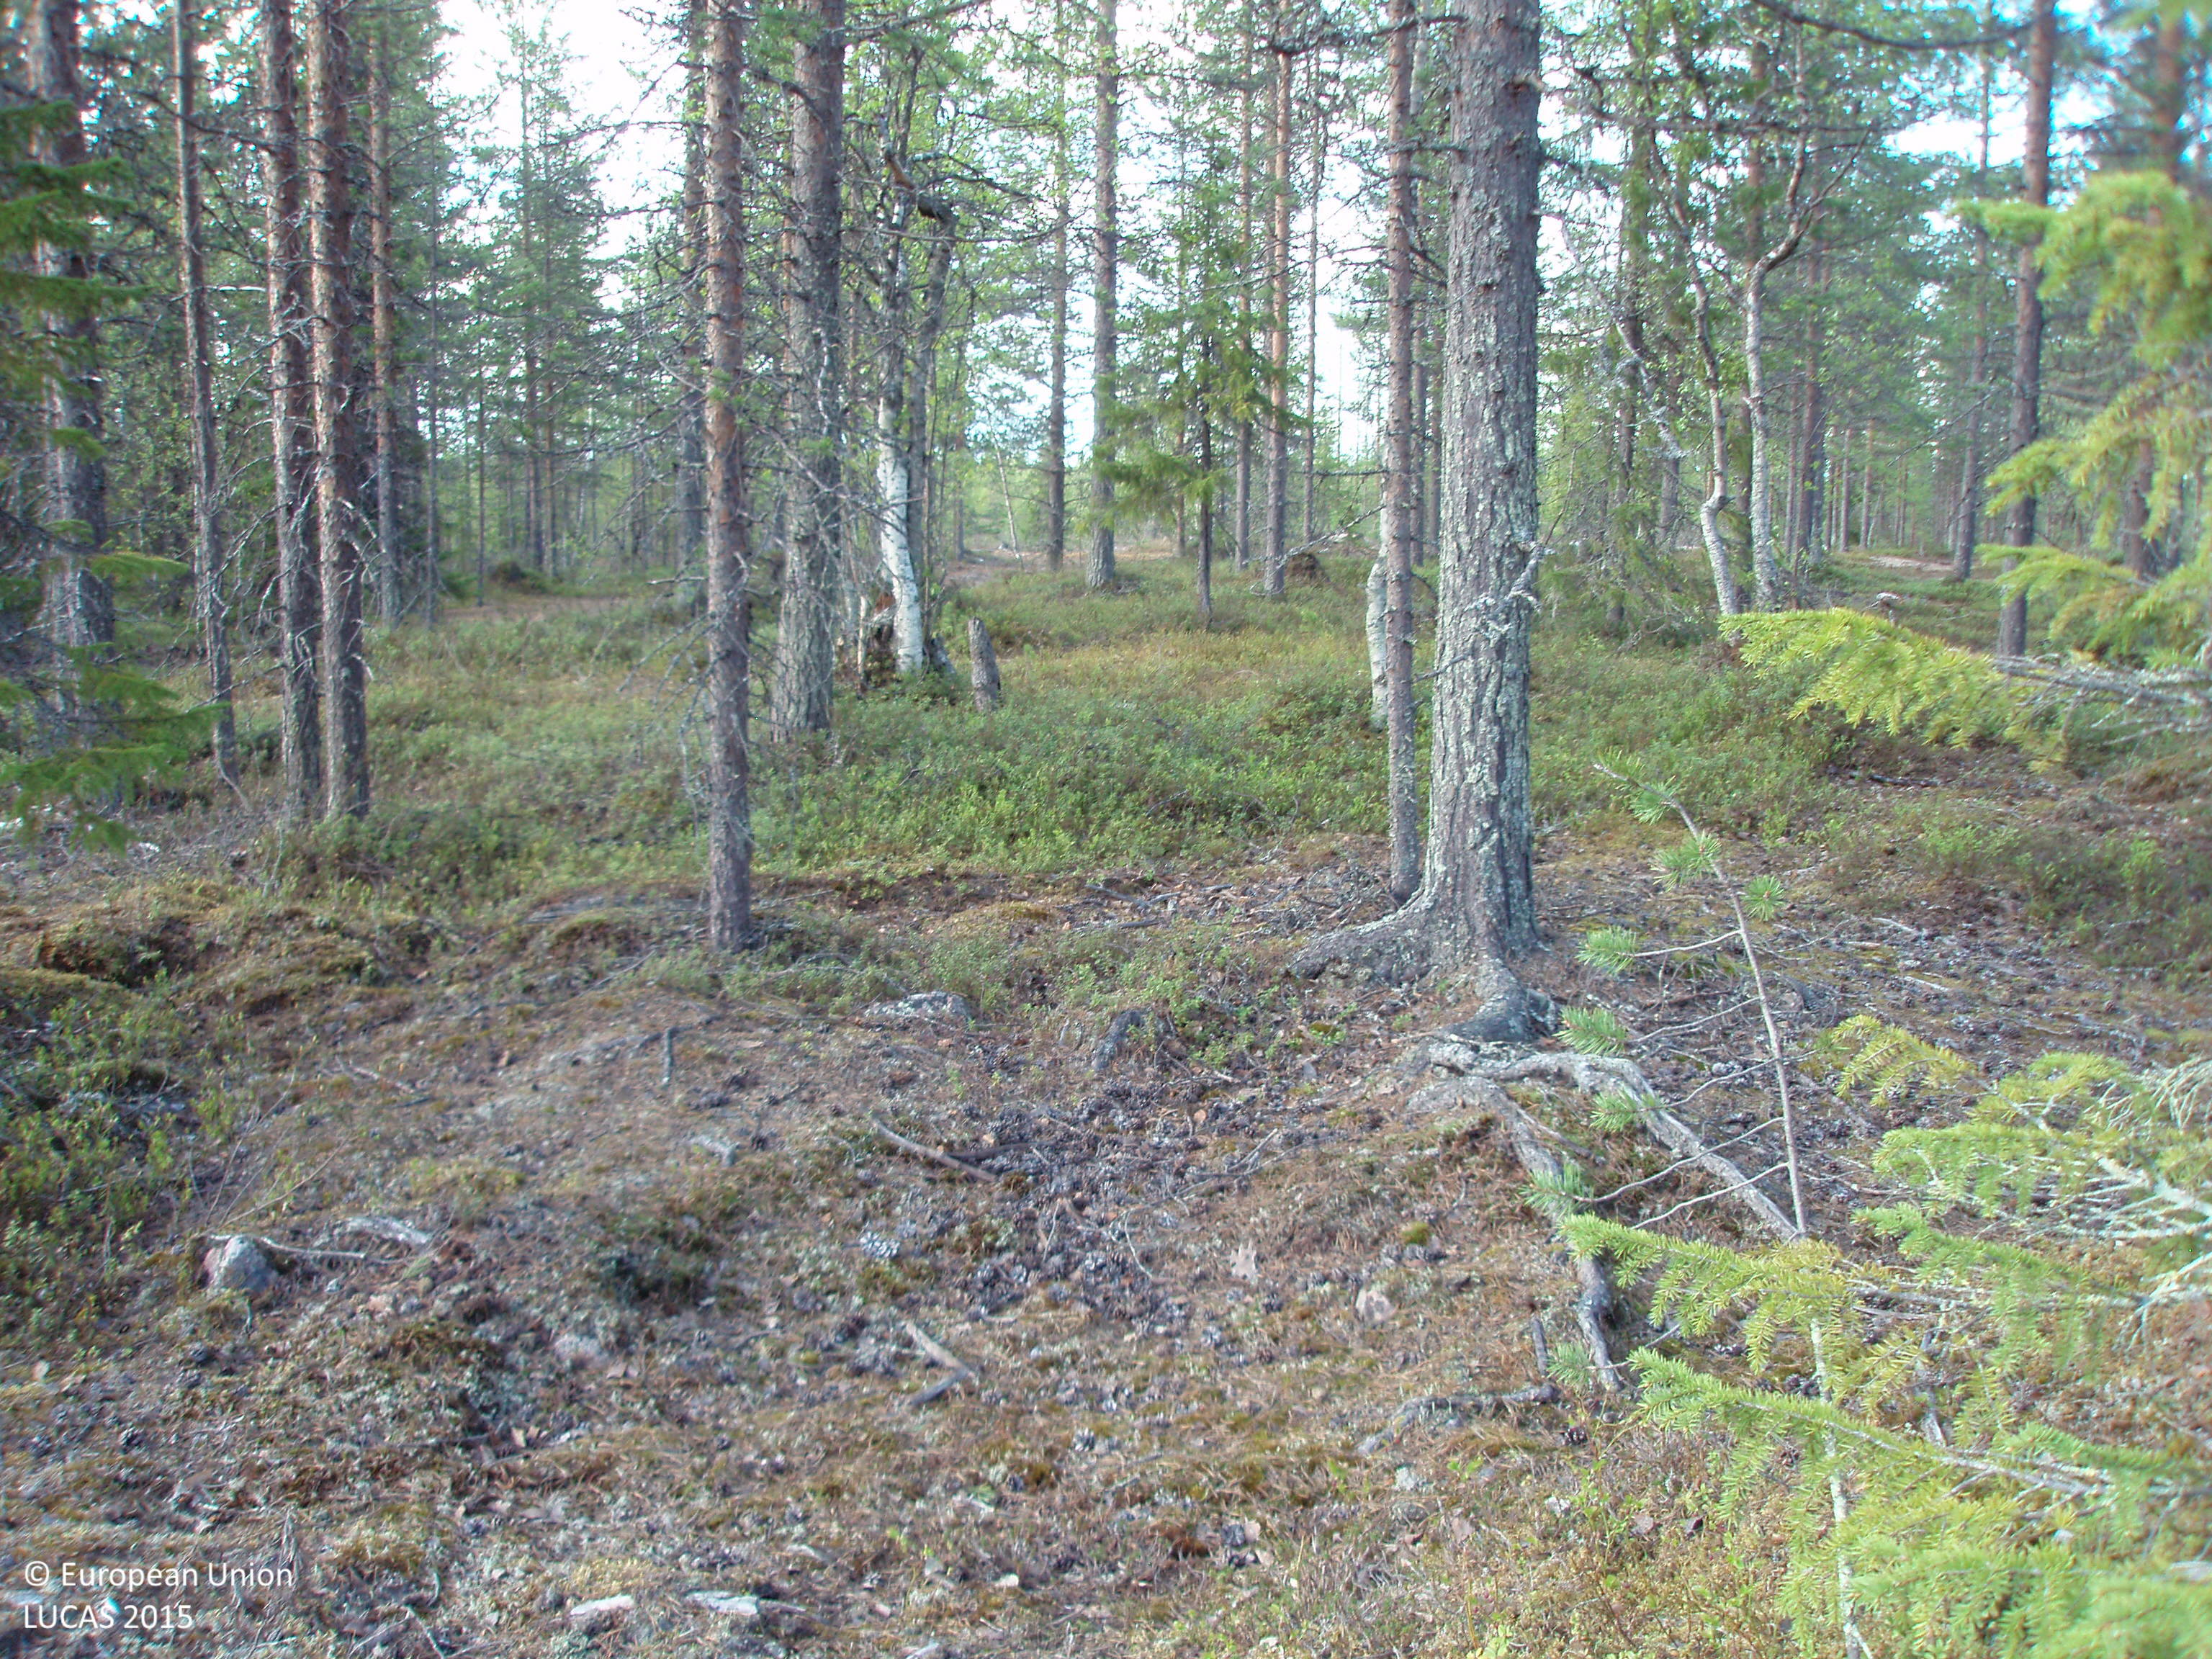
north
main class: Woodland
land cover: Pine dominated coniferous woodland
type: boreal forest
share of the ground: 50 - 75 %
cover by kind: coniferous forest trees 65 %, shrubs 20 %, broadleaved forest trees 5 %, lichens and mosses 5 %, unconsolidated bare surface 5 %
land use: Forestry
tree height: > 5 m
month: June
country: FI
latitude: 66.6787
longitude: 26.5419
